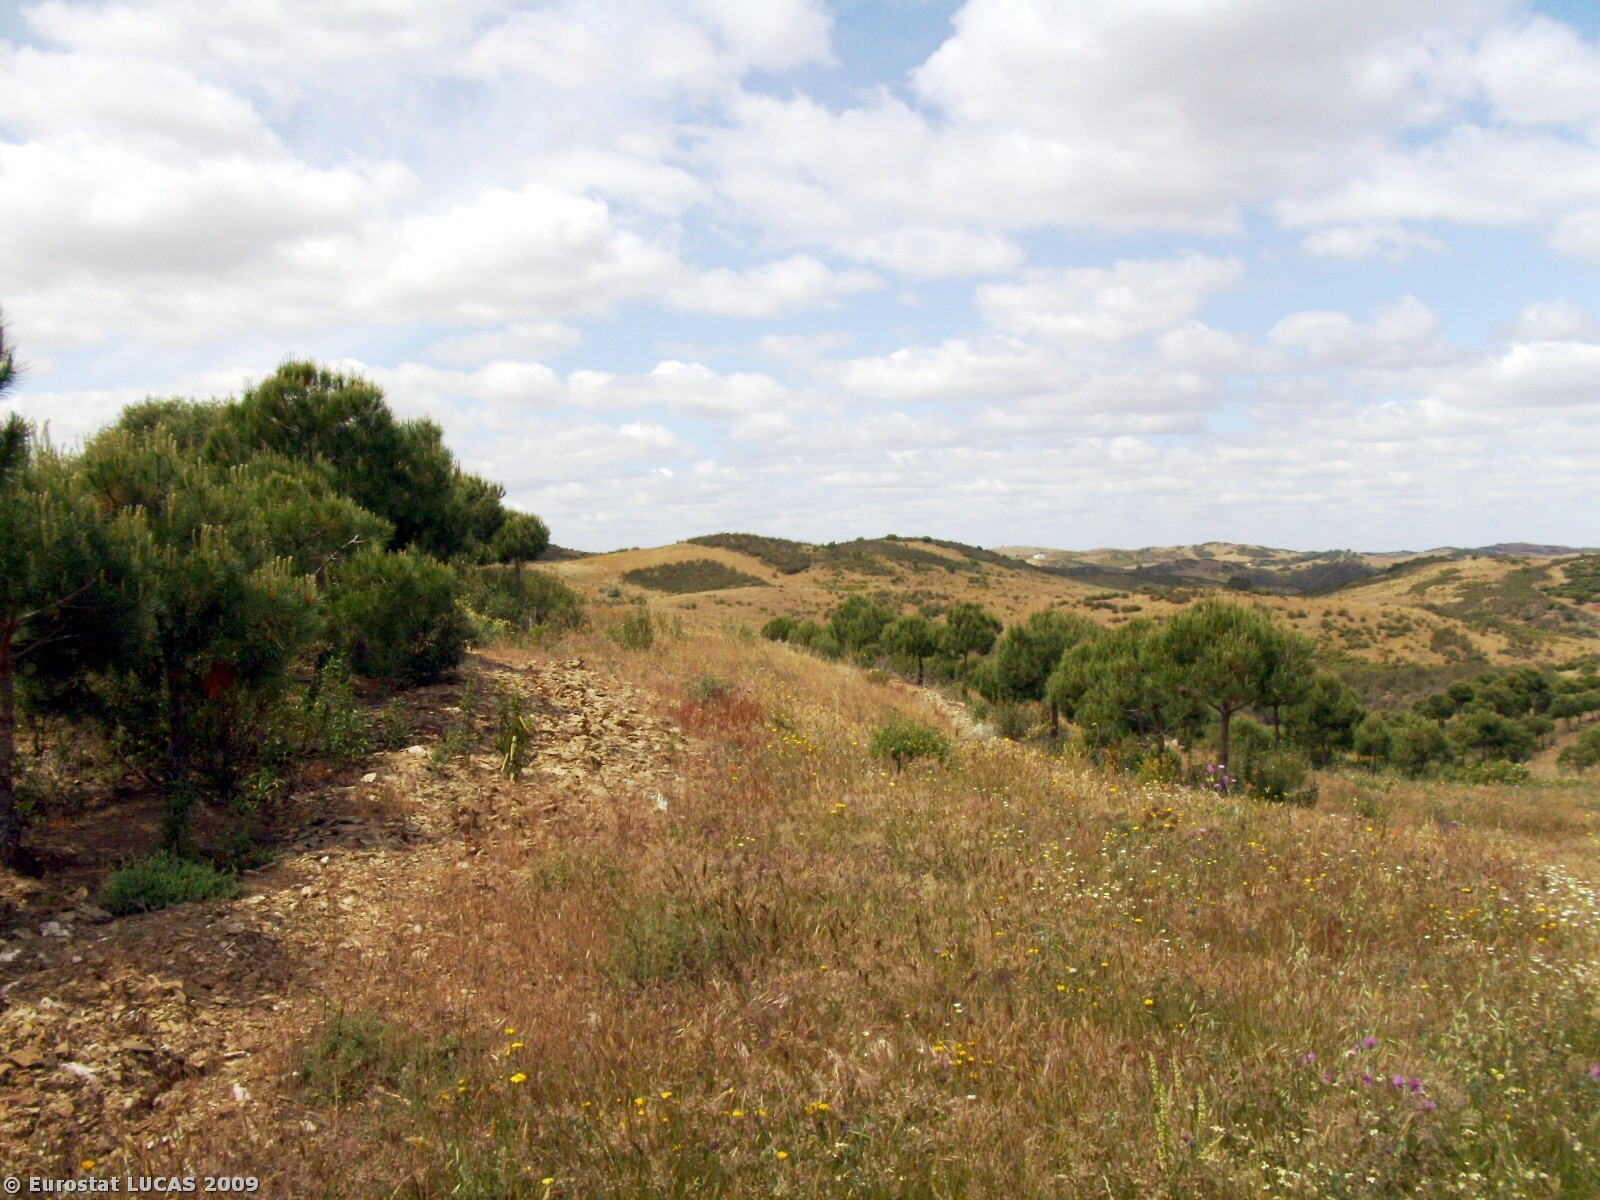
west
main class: Woodland
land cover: Coniferous woodland
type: coniferous forest of the mediterranean region
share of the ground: 10 - 25 %
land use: Forestry
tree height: > 5 m
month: April
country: PT
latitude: 37.5785
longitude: -7.7603
